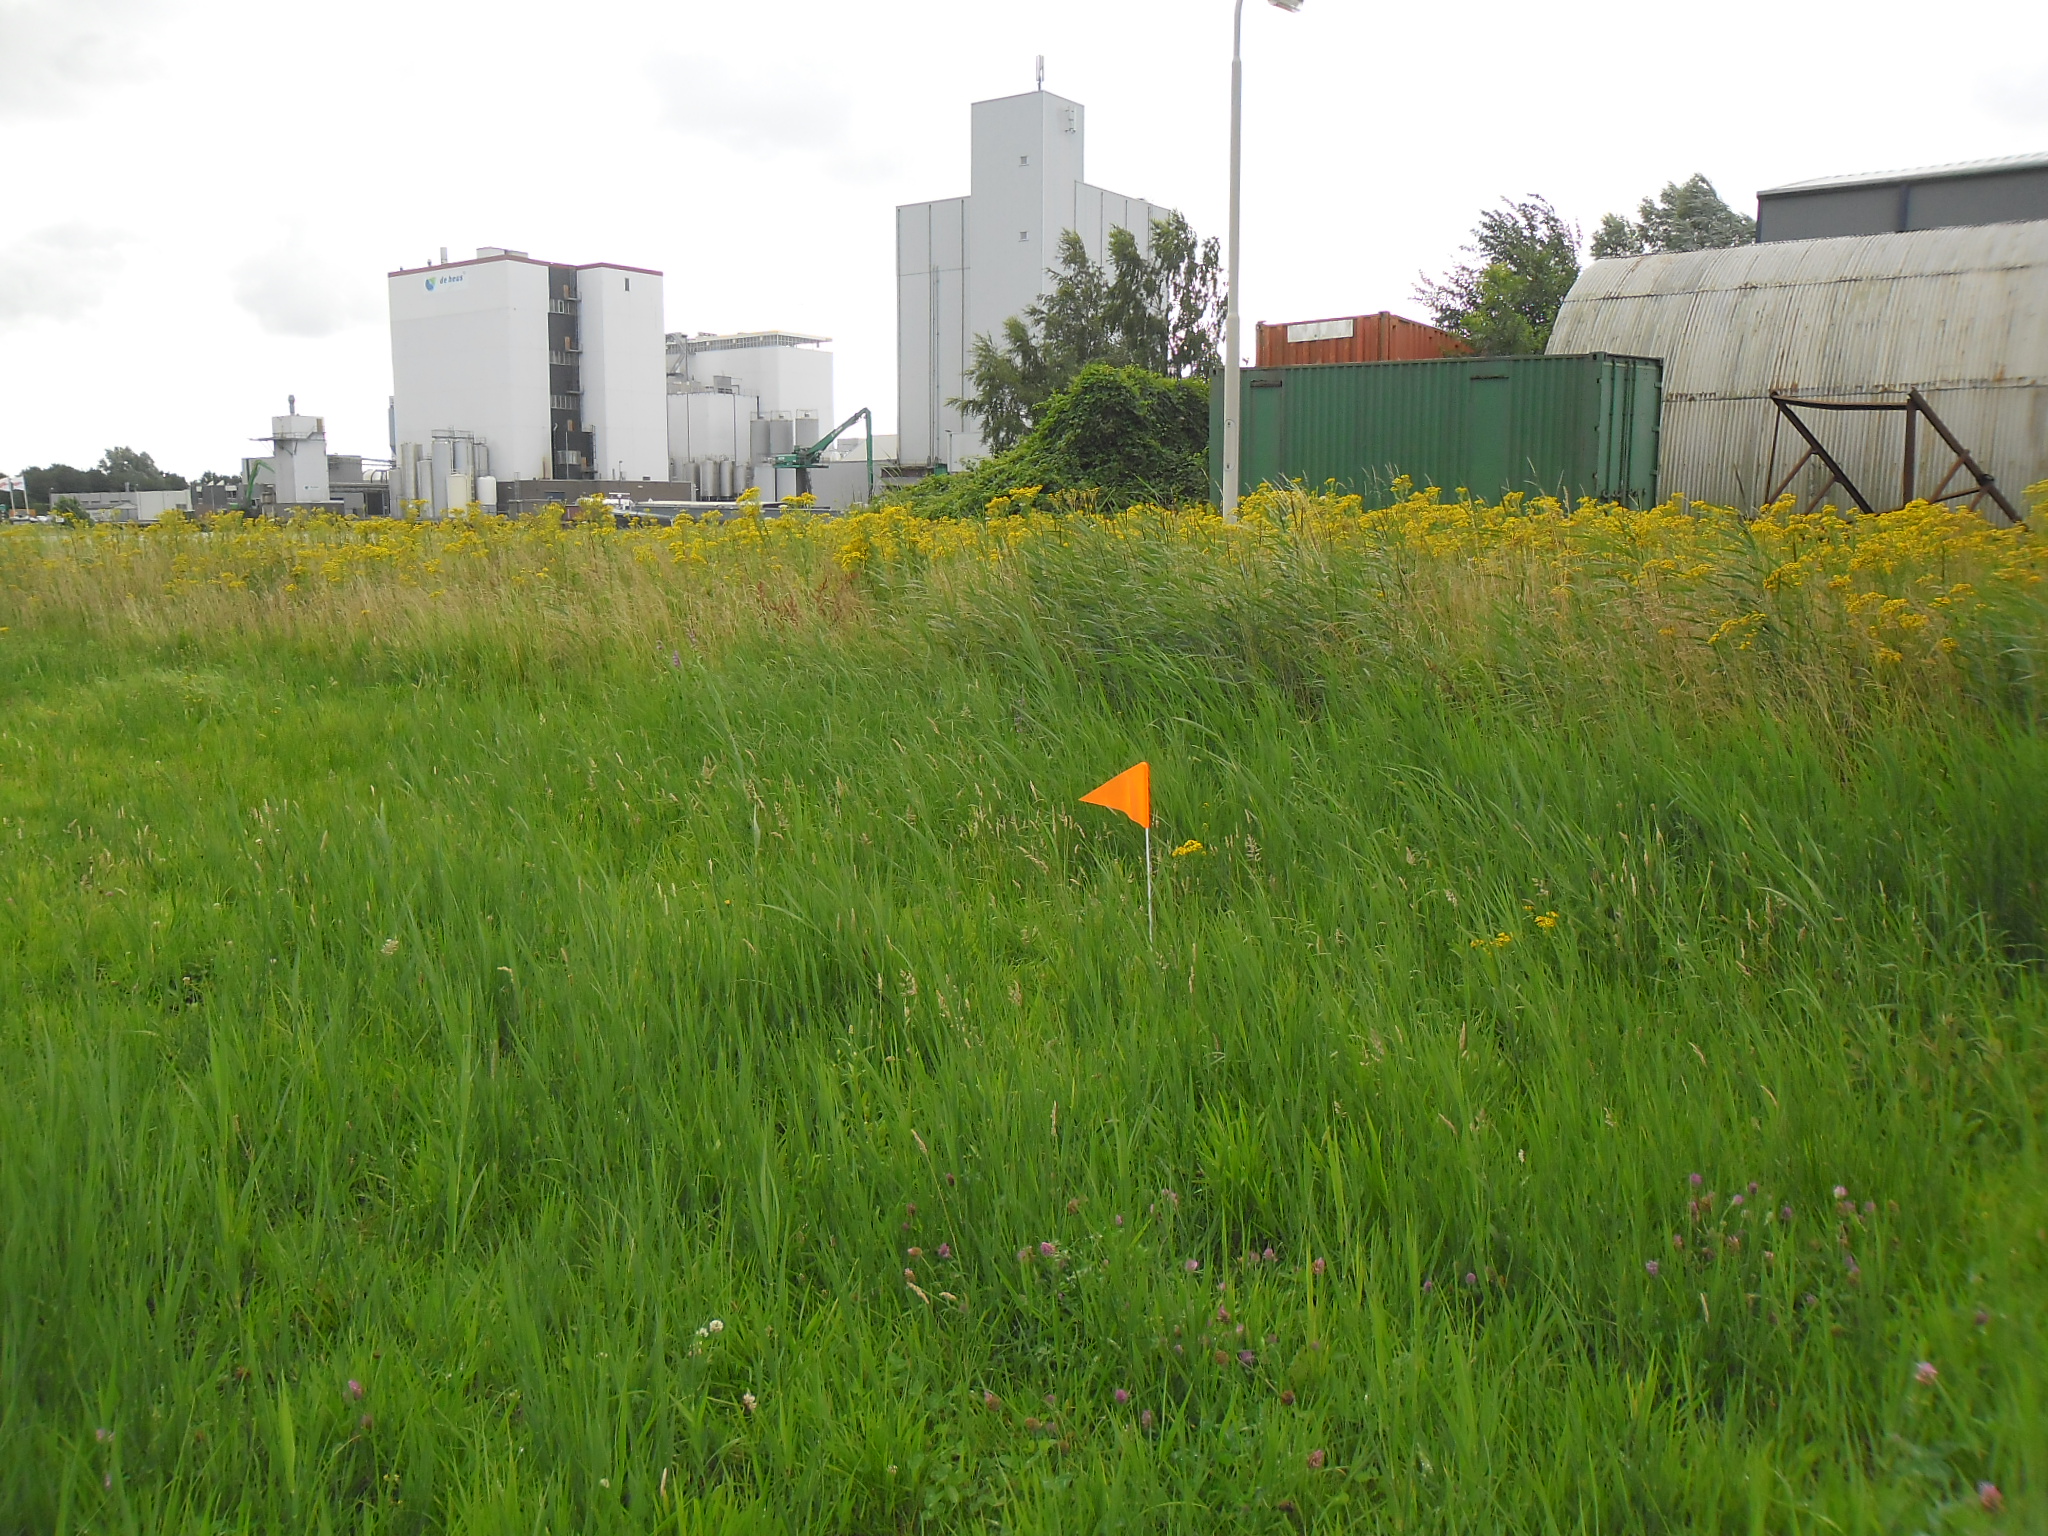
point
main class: Grassland
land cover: Grassland without tree/shrub cover
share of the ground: > 75 %
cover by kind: herbaceous plants 100 %
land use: Logistics and storage
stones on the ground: < 10 %
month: July
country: NL
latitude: 52.6936
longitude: 6.1674
